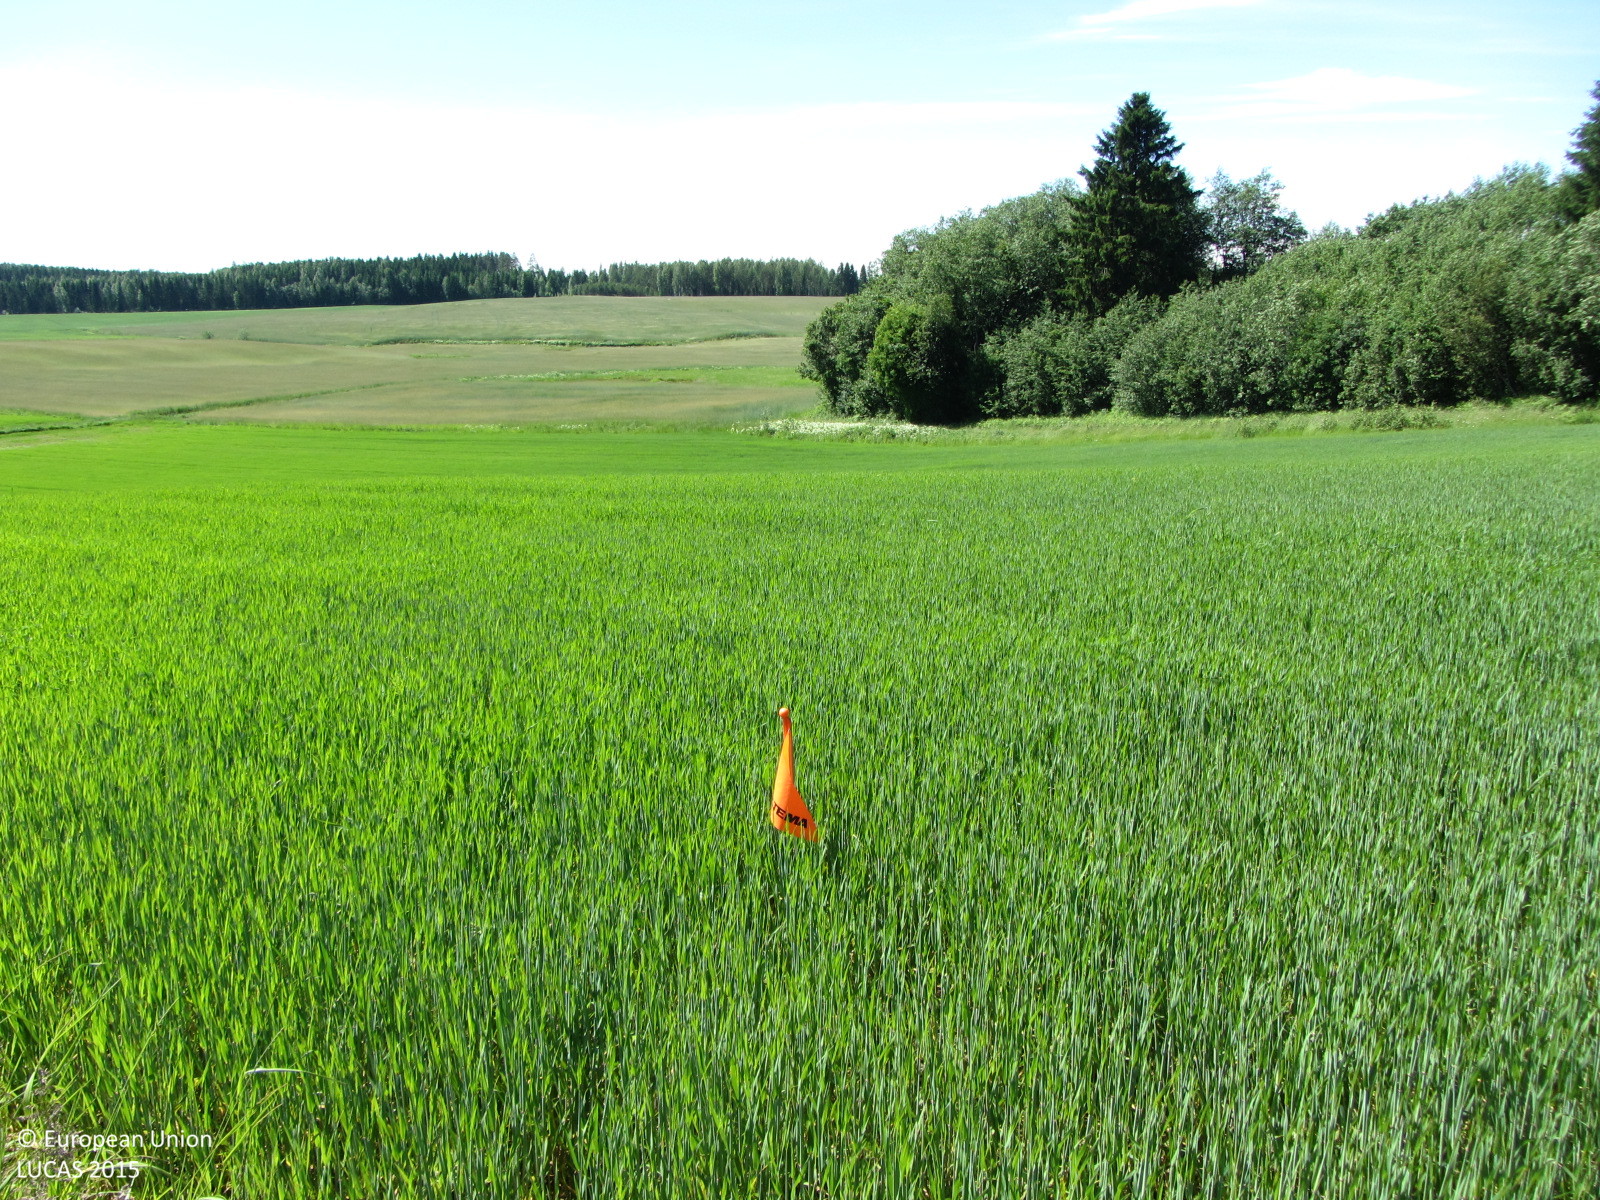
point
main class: Cropland
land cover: Barley
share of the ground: > 75 %
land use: Agriculture (excluding fallow land and kitchen gardens)
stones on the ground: < 10 %
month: June
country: FI
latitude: 60.3173
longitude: 23.2817
